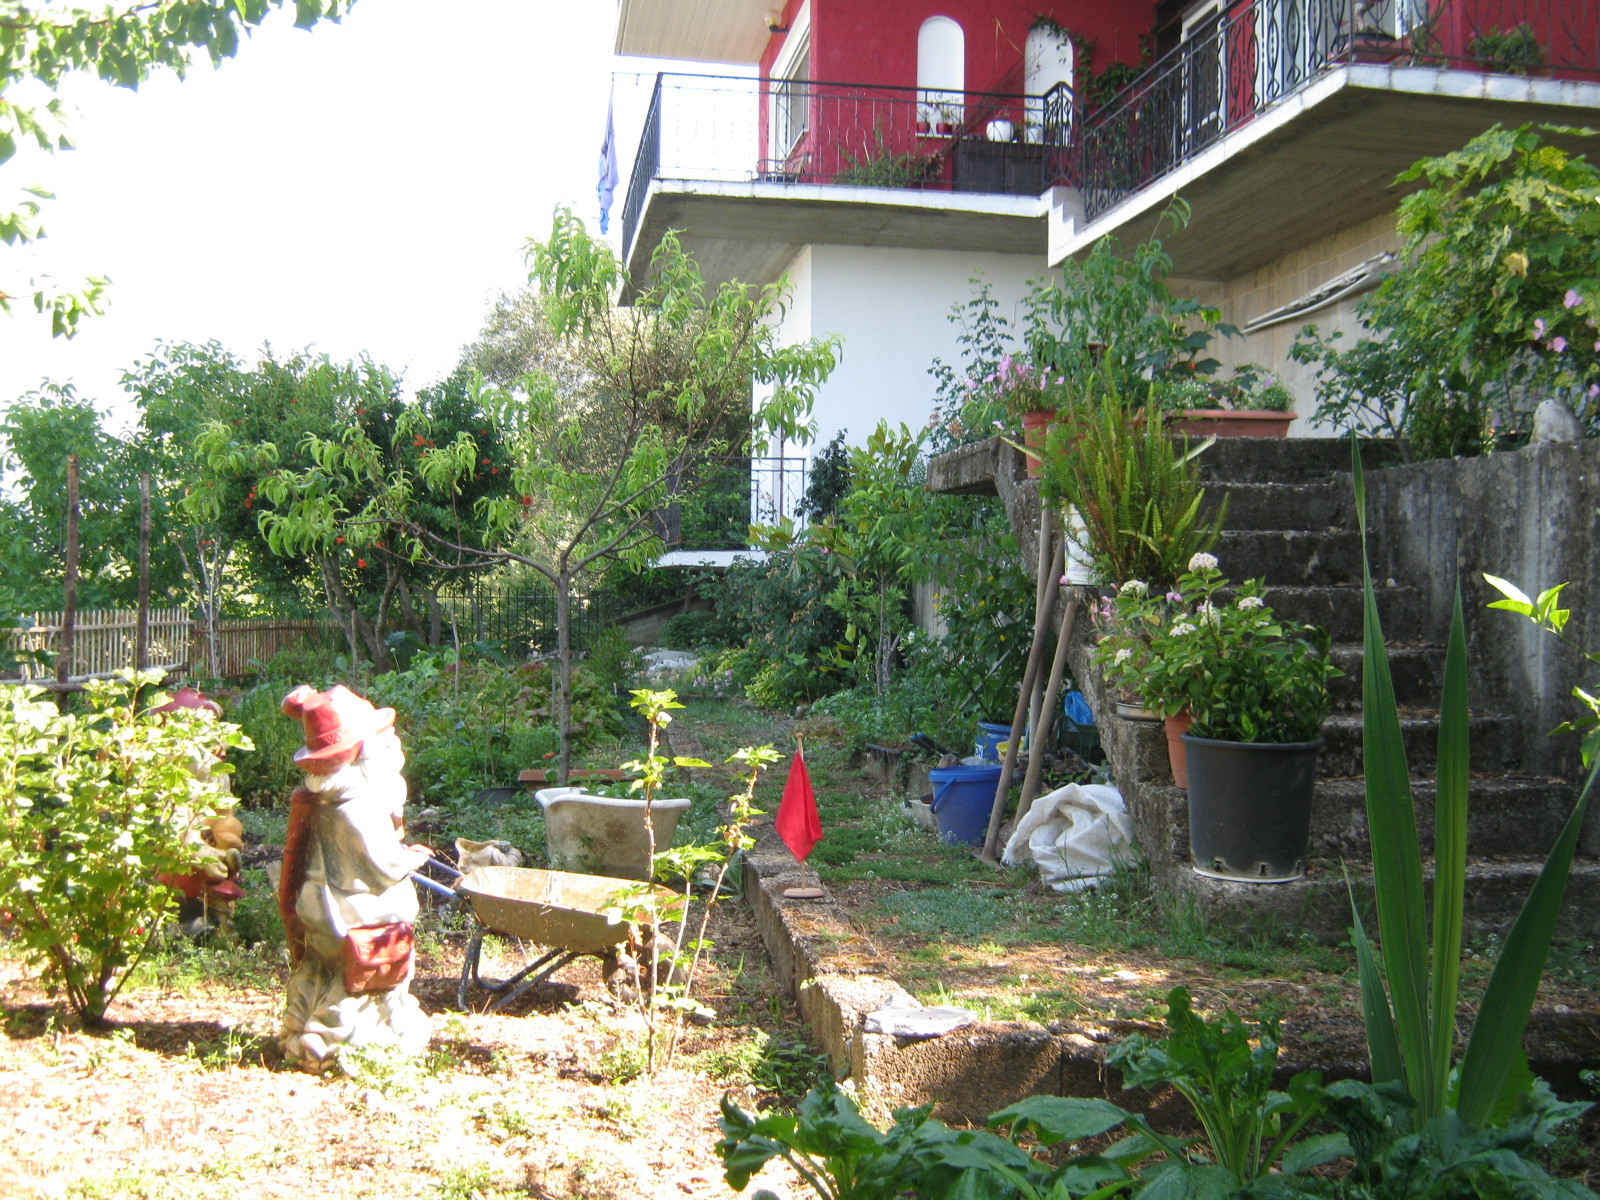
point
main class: Grassland
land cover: Grassland with sparse tree/shrub cover
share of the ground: > 75 %
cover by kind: herbaceous plants 90 %, broadleaved forest trees 5 %, shrubs 5 %
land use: Residential
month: June
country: GR
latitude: 39.4634
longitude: 20.5165
